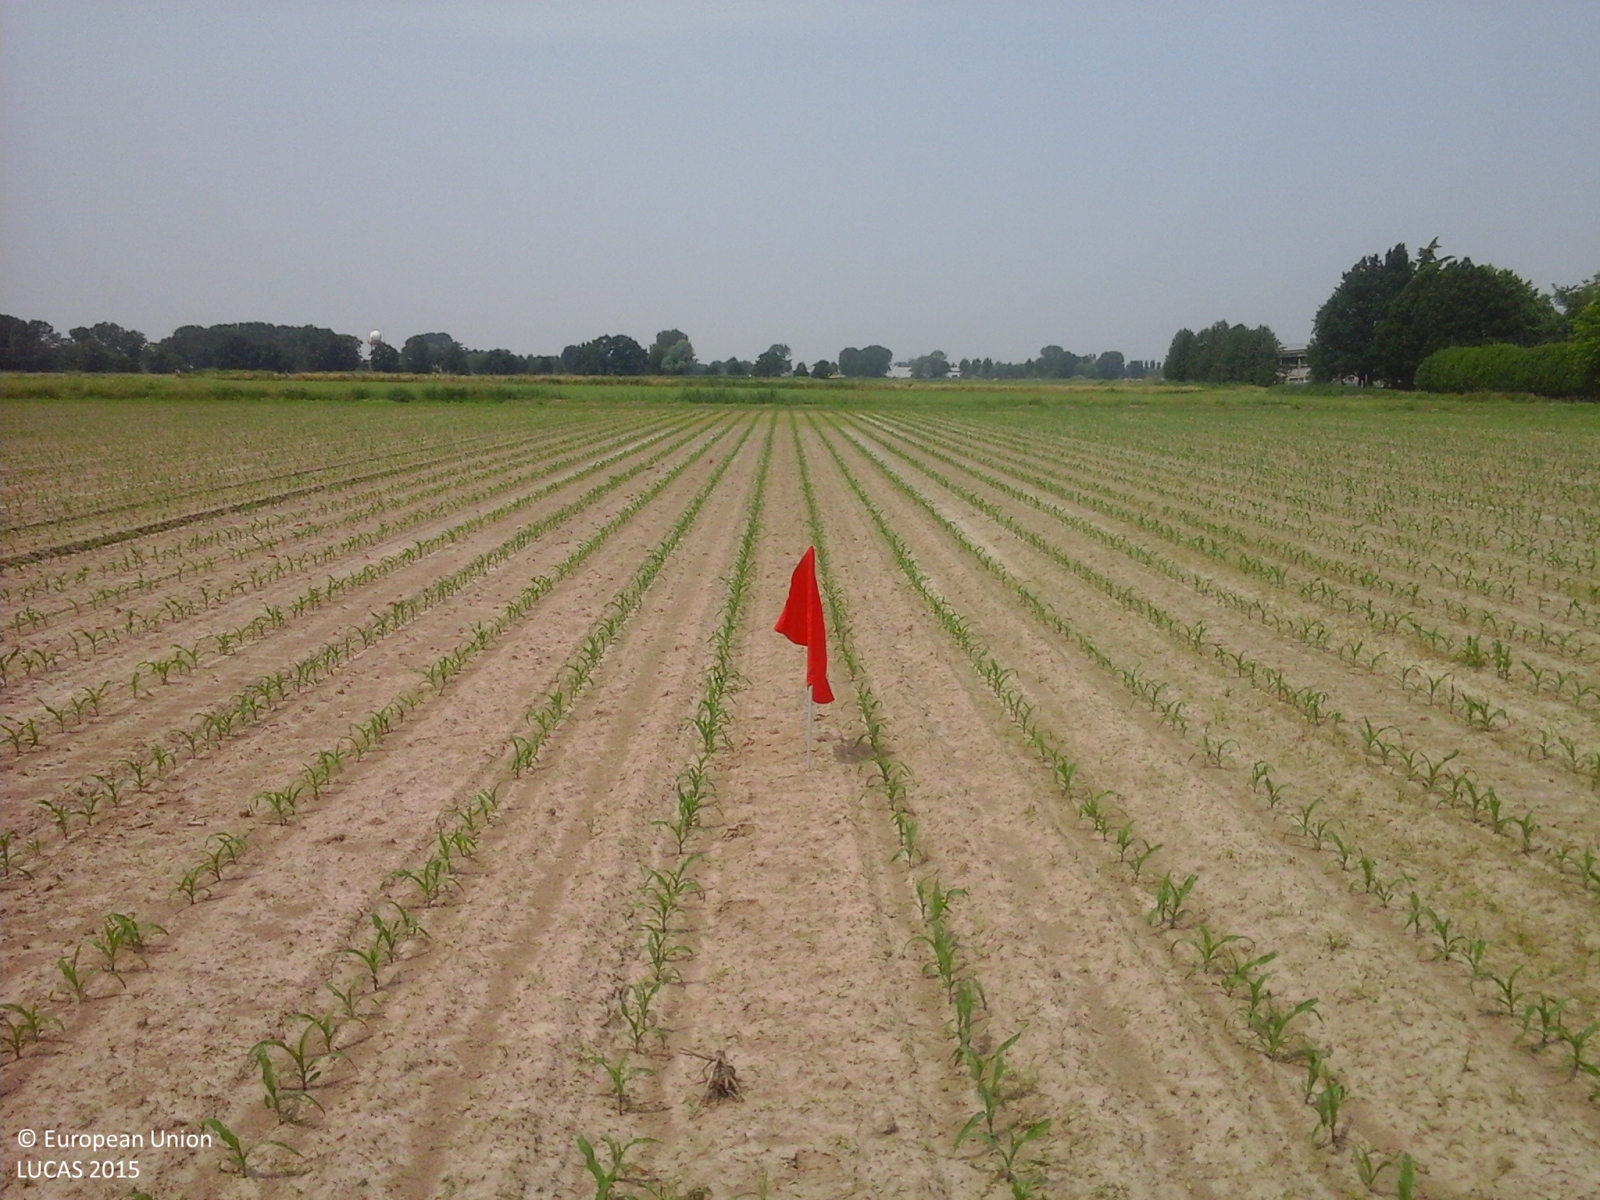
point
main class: Cropland
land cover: Maize
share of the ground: < 10 %
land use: Agriculture (excluding fallow land and kitchen gardens)
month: May
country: IT
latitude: 45.3399
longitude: 9.2994
